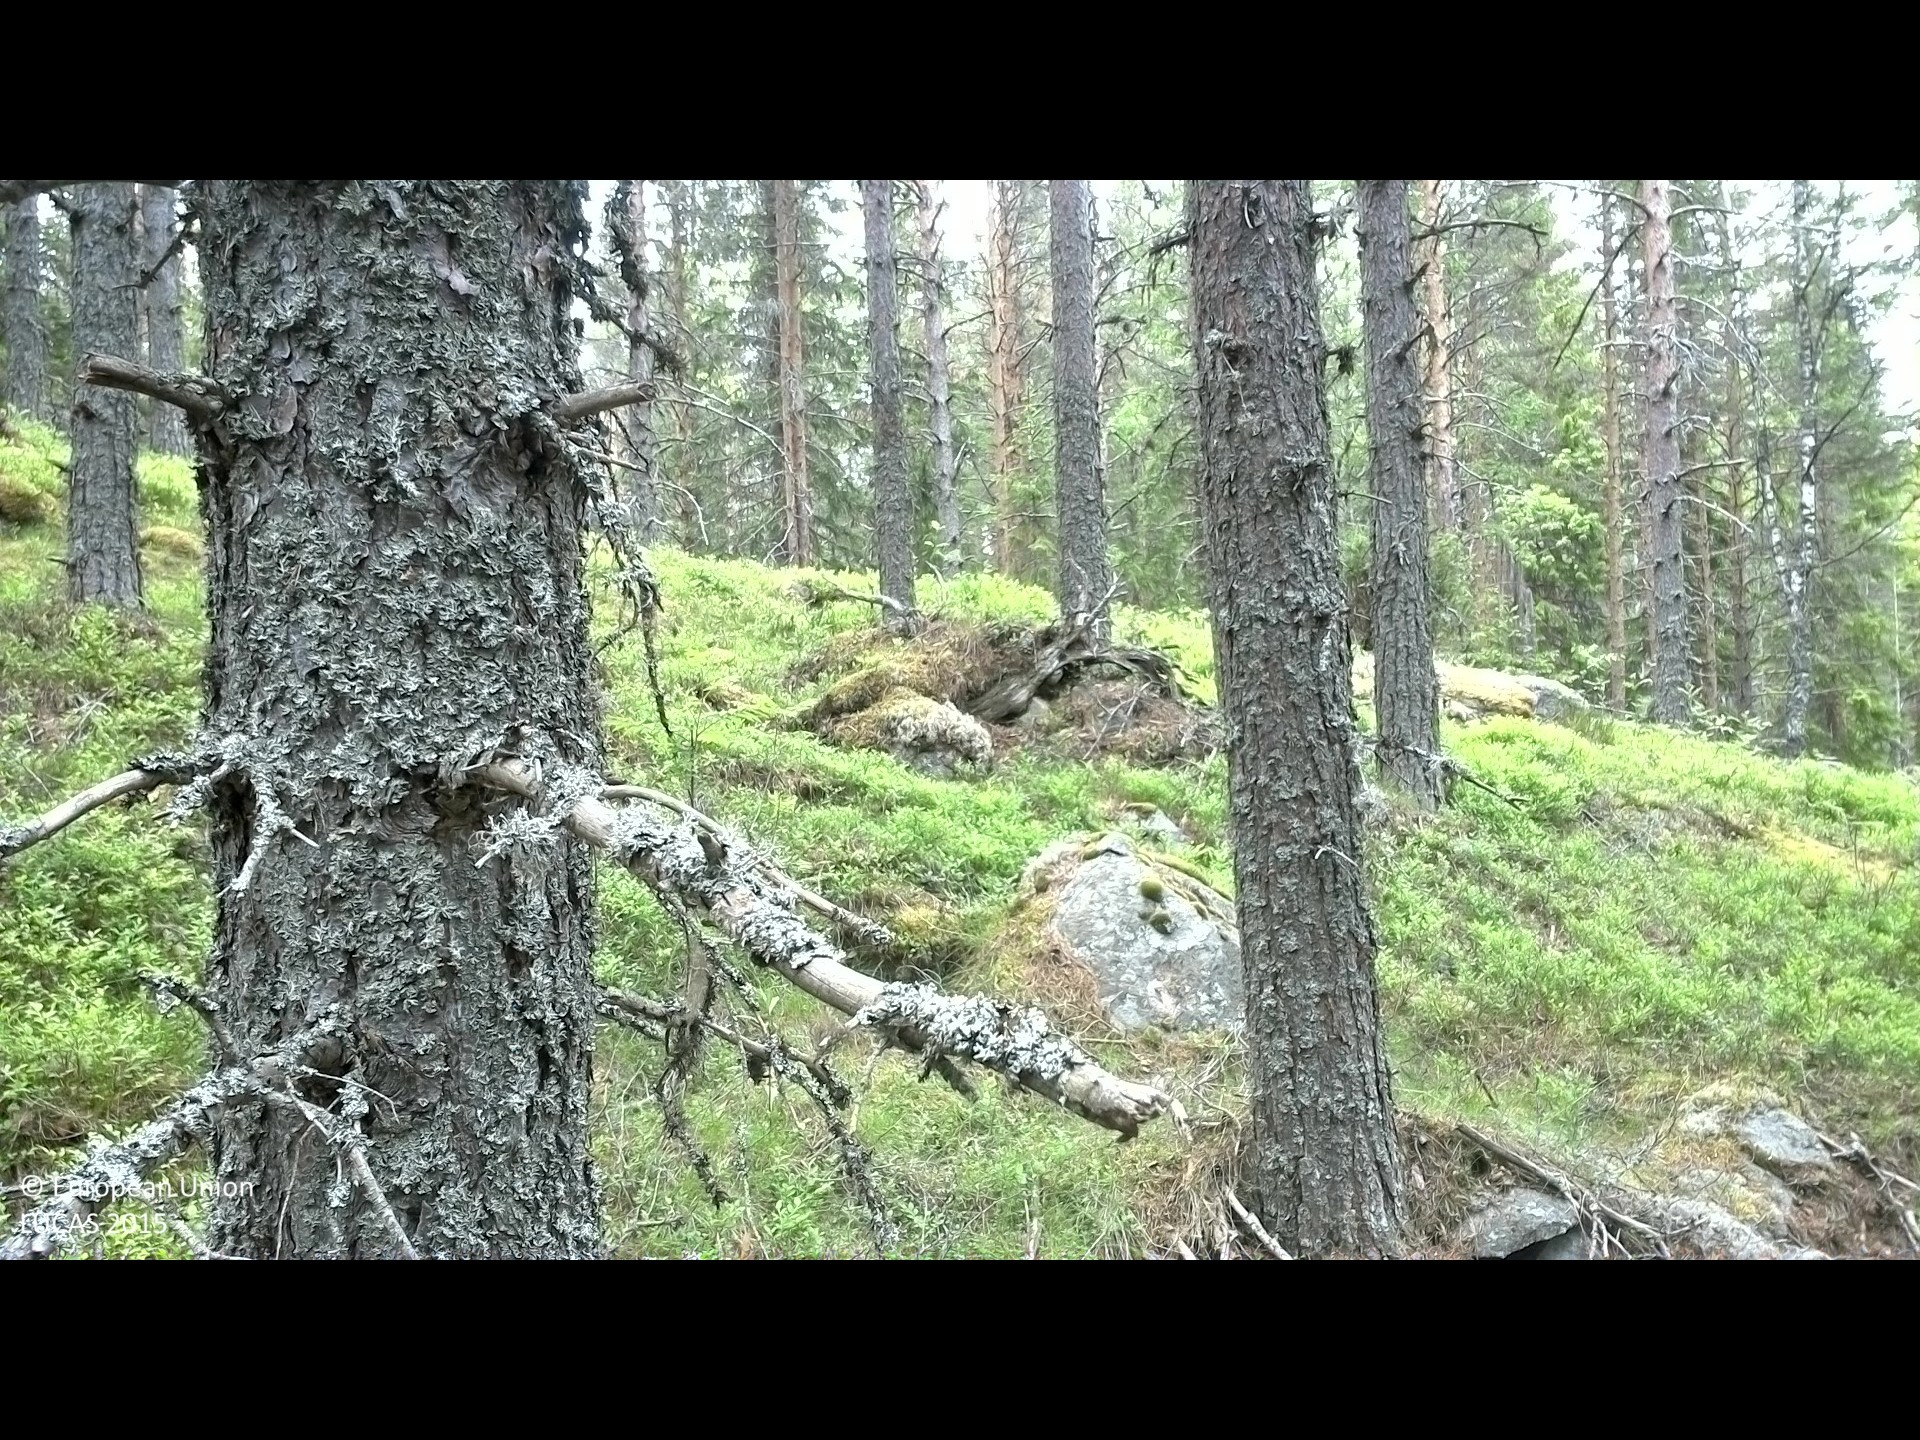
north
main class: Woodland
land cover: Pine dominated coniferous woodland
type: boreal forest
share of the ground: 50 - 75 %
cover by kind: coniferous forest trees 50 %, shrubs 30 %, lichens and mosses 20 %
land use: Forestry
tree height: > 5 m
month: June
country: SE
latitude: 62.0068
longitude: 16.3795
